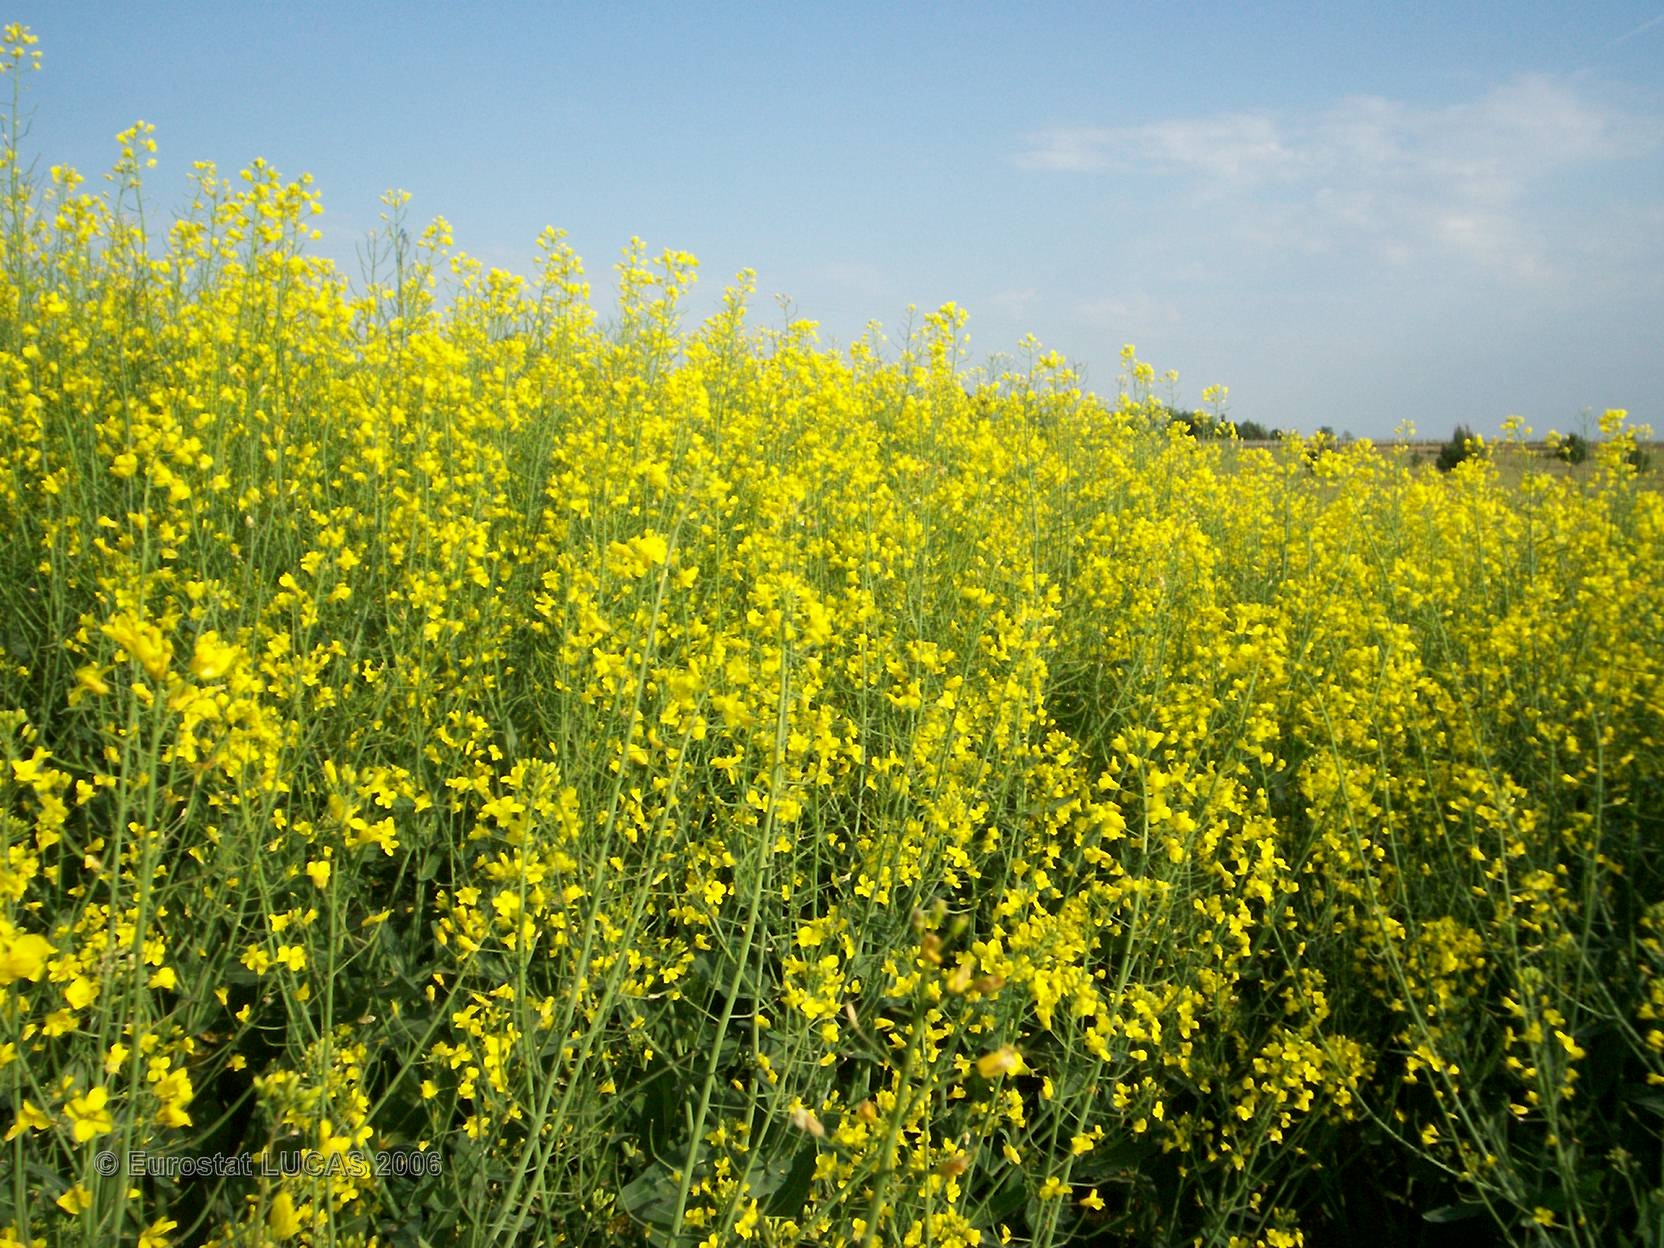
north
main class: Cropland
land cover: Vineyards
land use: Agriculture (excluding fallow land and kitchen gardens)
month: May
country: FR
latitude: 45.5895
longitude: -0.7532
